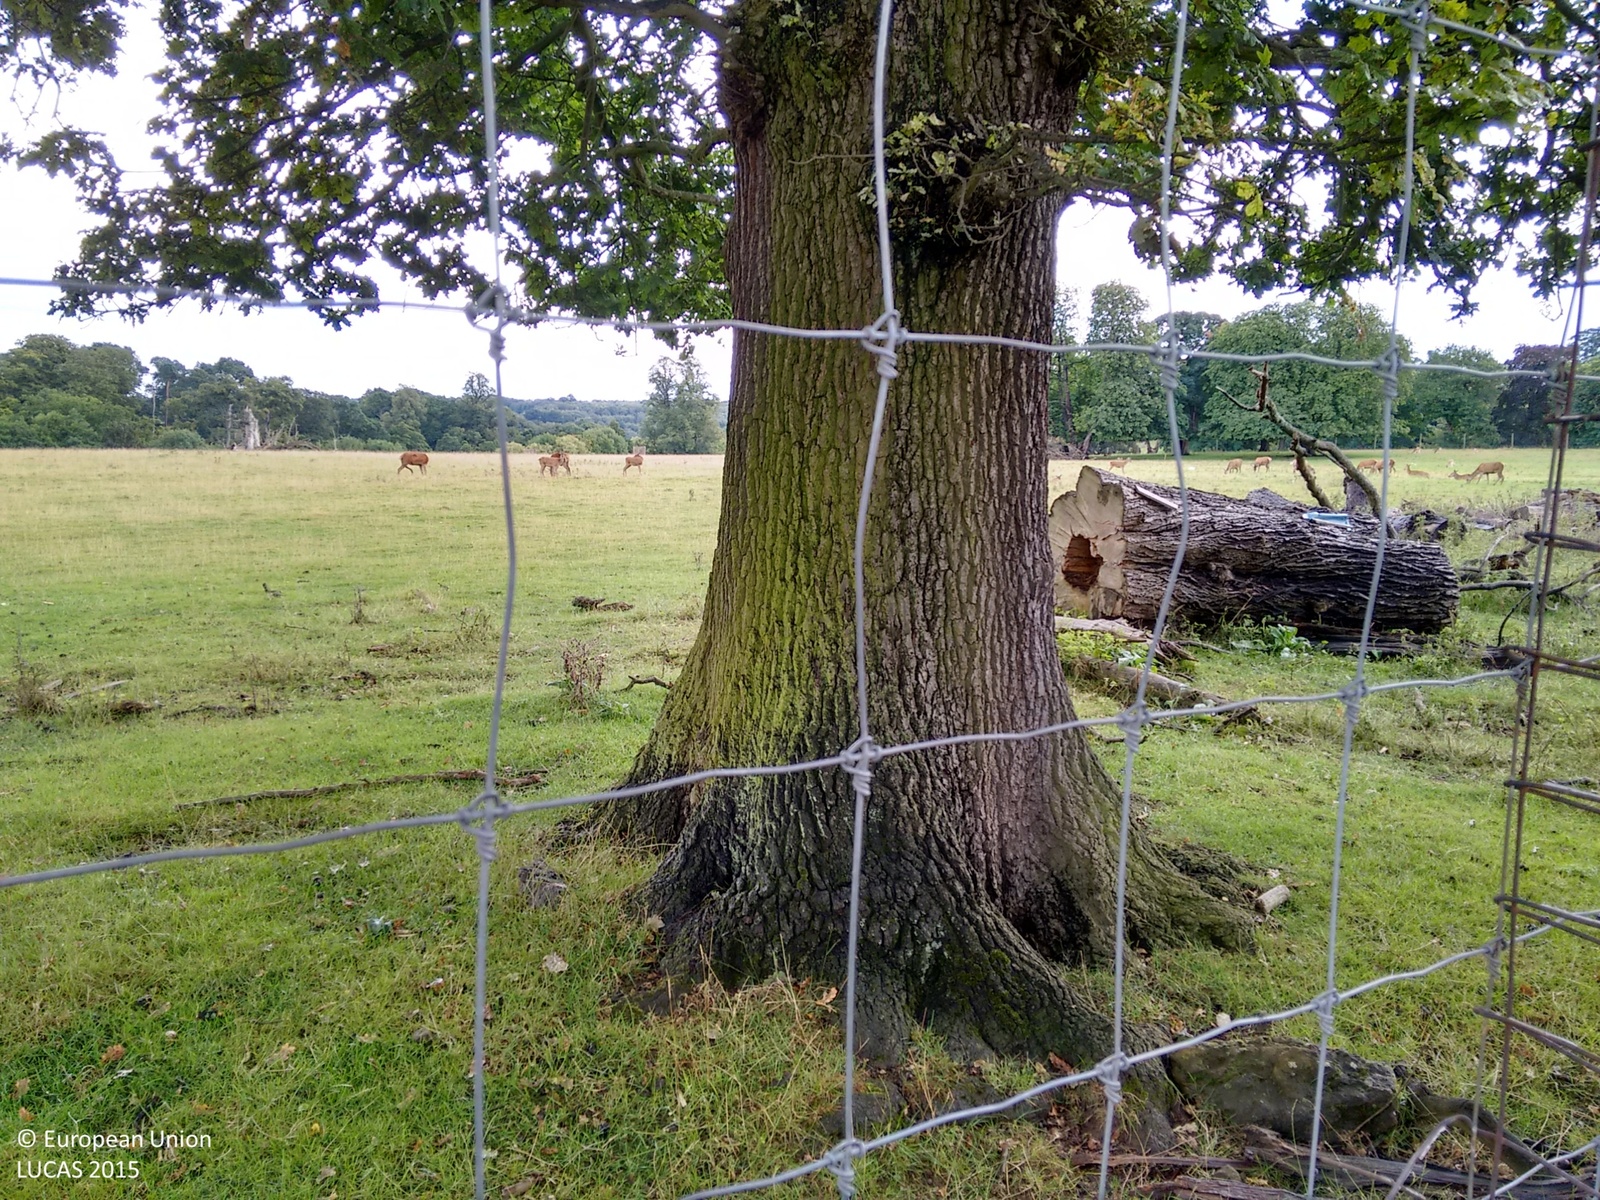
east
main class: Grassland
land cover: Grassland without tree/shrub cover
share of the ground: > 75 %
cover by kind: herbaceous plants 100 %
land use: Agriculture (excluding fallow land and kitchen gardens)
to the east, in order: Grassland without tree/shrub cover; Fences; Grass margins; Tracks
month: September
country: GB
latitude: 52.8017
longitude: -1.4564
